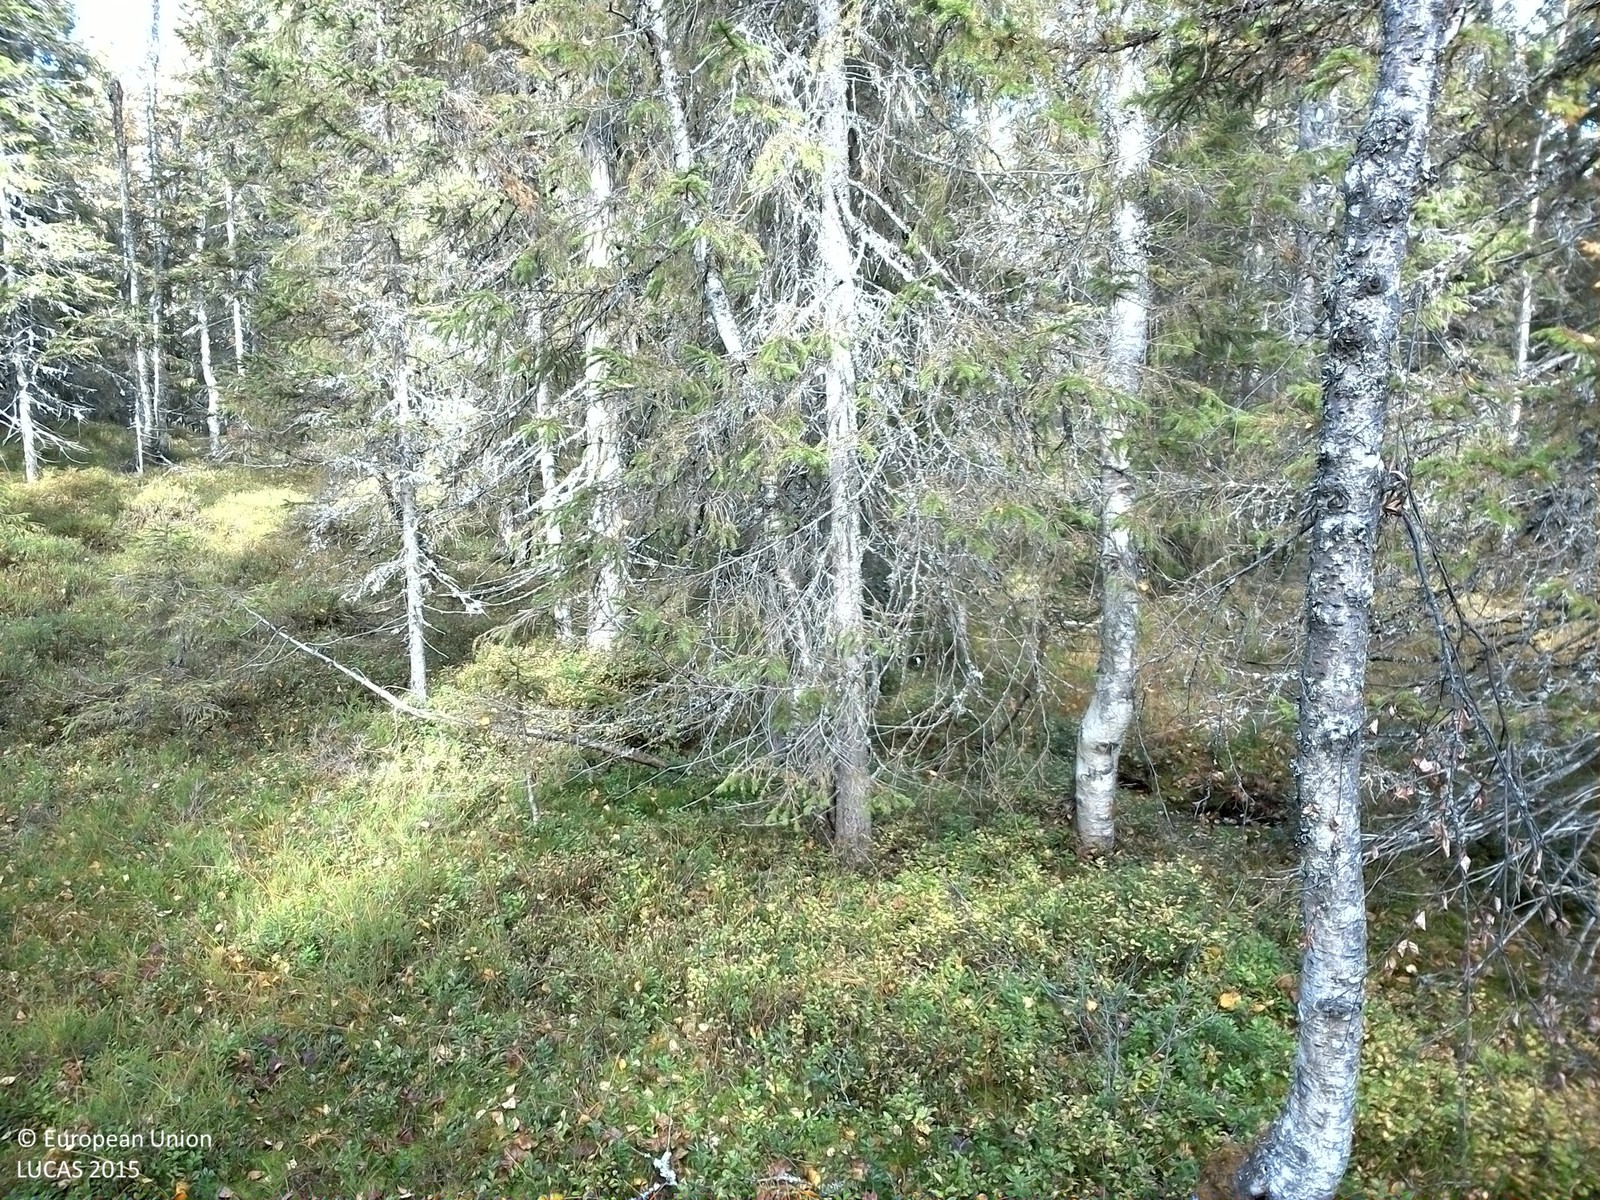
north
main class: Woodland
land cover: Spruce dominated mixed woodland
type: boreal forest
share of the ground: 25 - 50 %
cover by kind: coniferous forest trees 30 %, shrubs 30 %, lichens and mosses 25 %, broadleaved forest trees 15 %
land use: Forestry
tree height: > 5 m
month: October
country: SE
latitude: 61.3779
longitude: 14.8692
